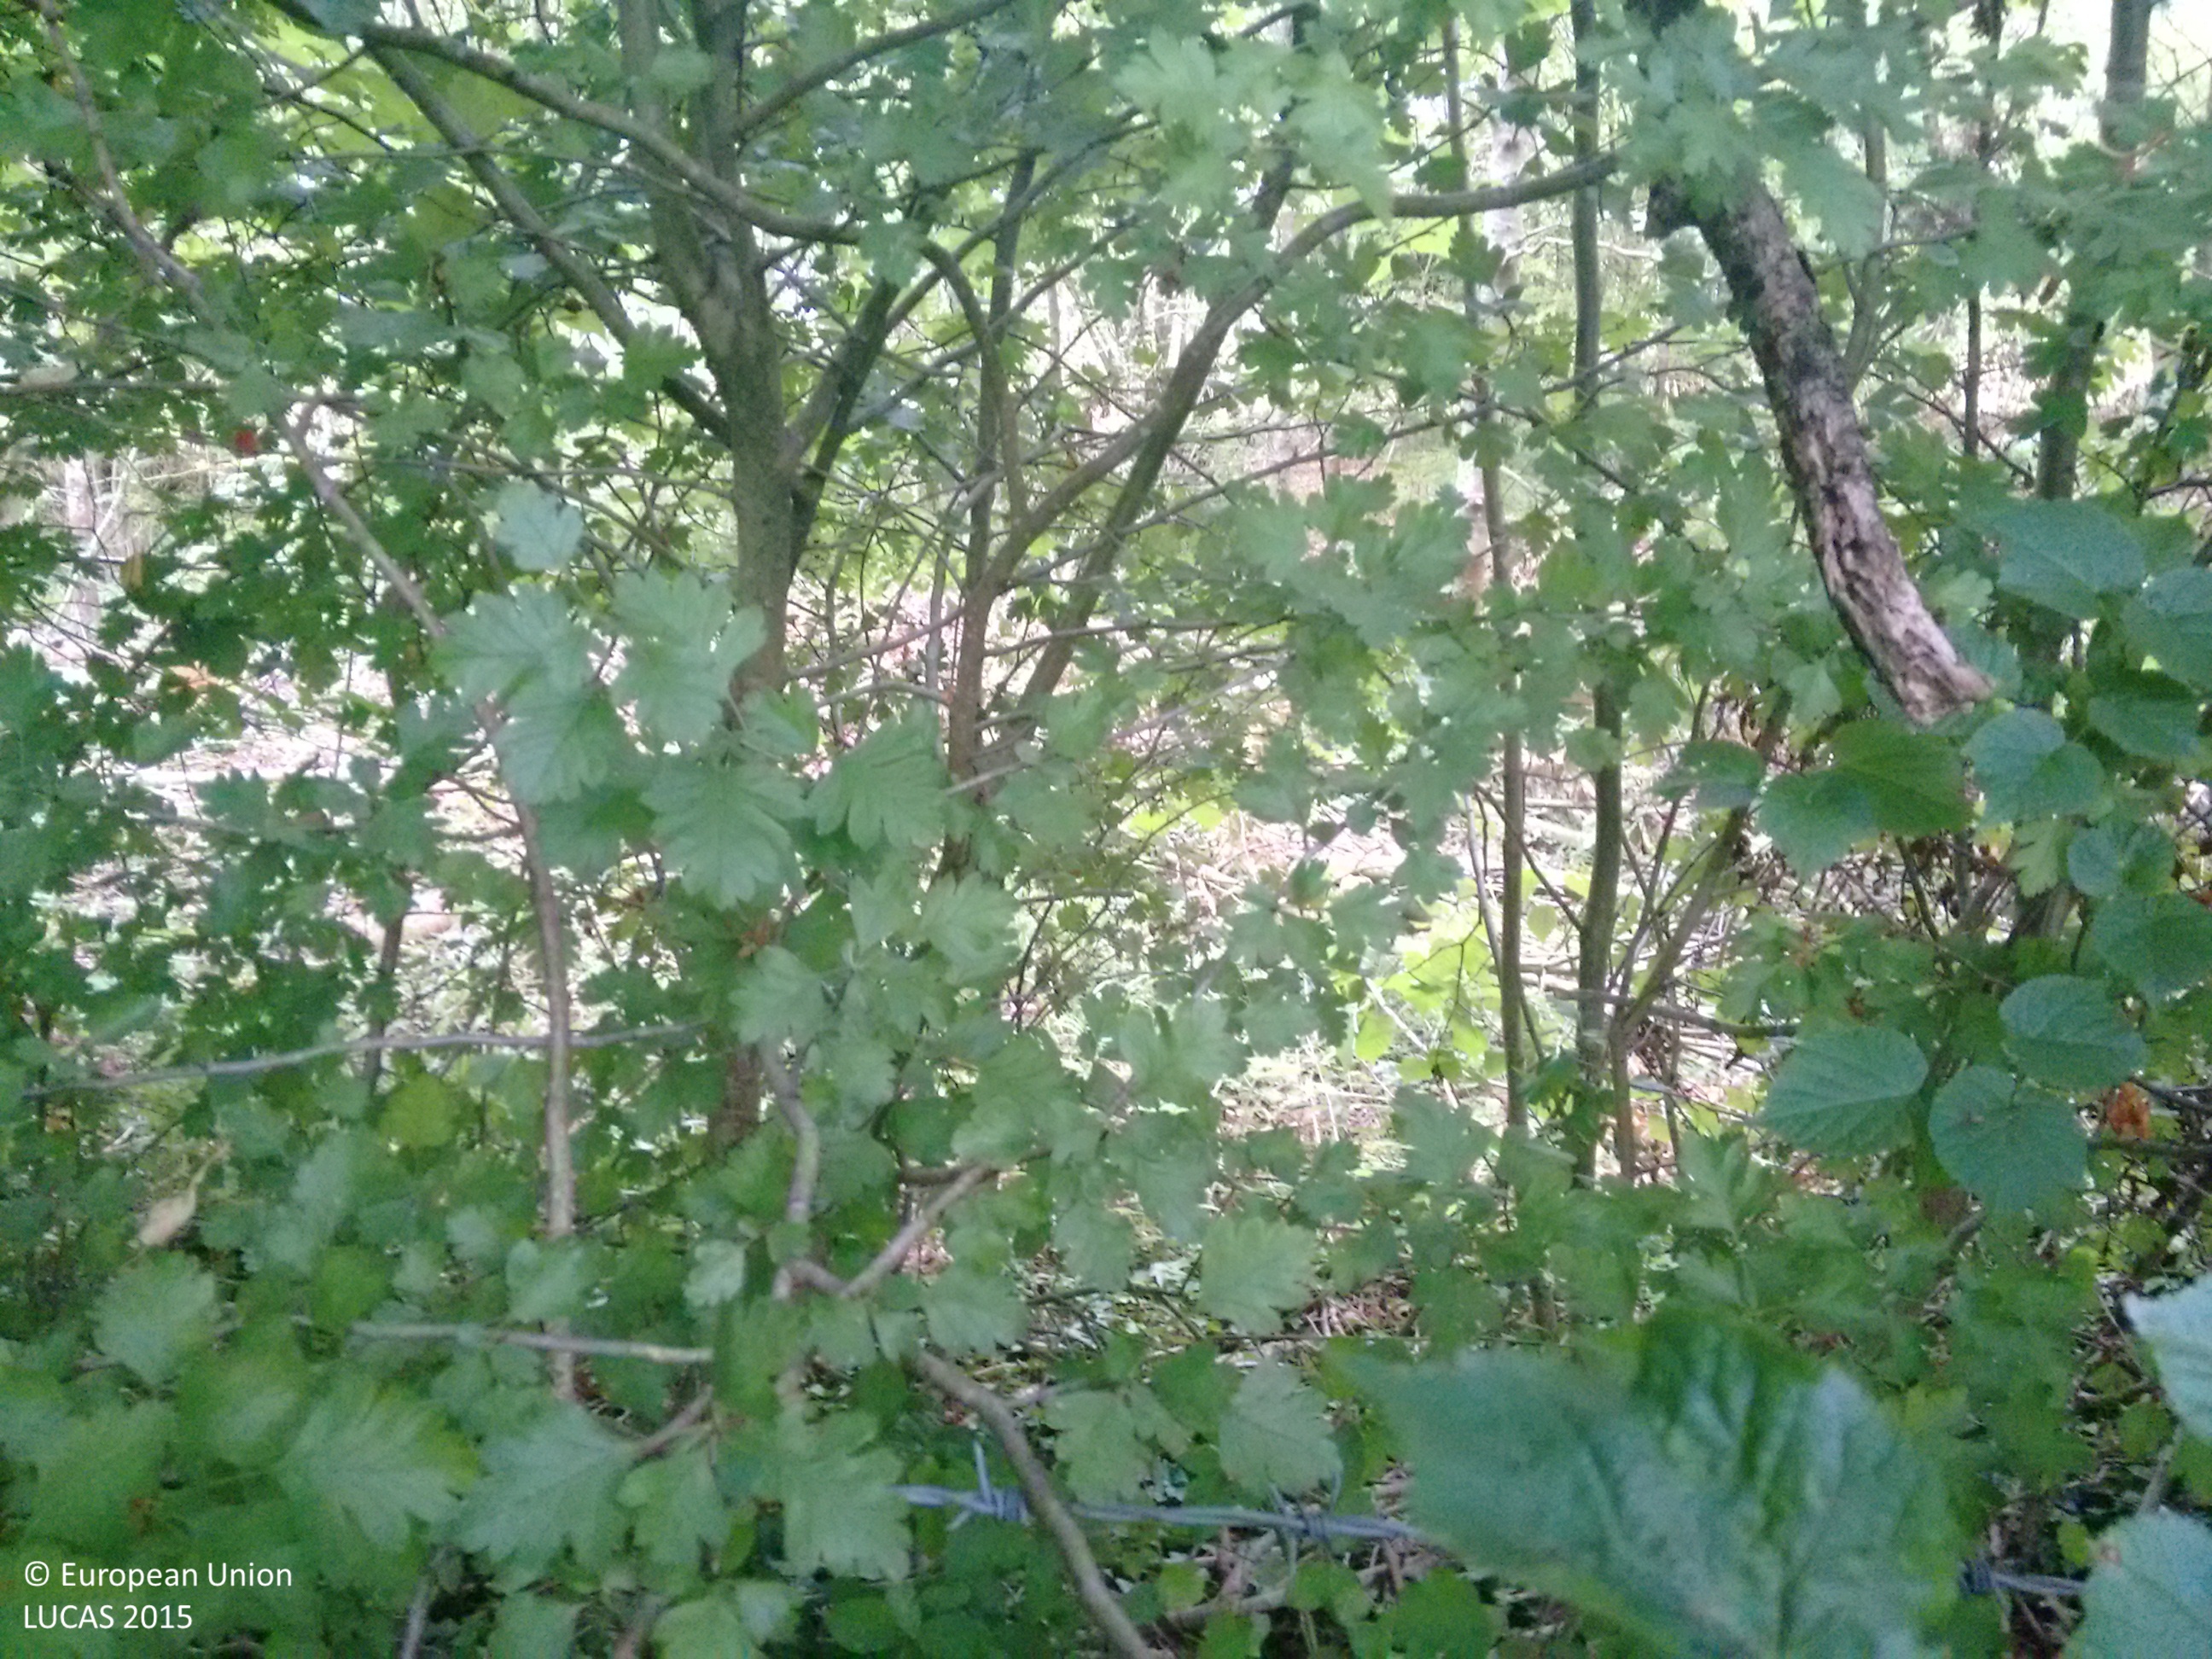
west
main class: Woodland
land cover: Broadleaved woodland
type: mesophytic deciduous forest
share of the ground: > 75 %
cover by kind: broadleaved forest trees 100 %
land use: Forestry
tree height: > 5 m
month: July
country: GB
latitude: 51.0002
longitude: -1.1180
